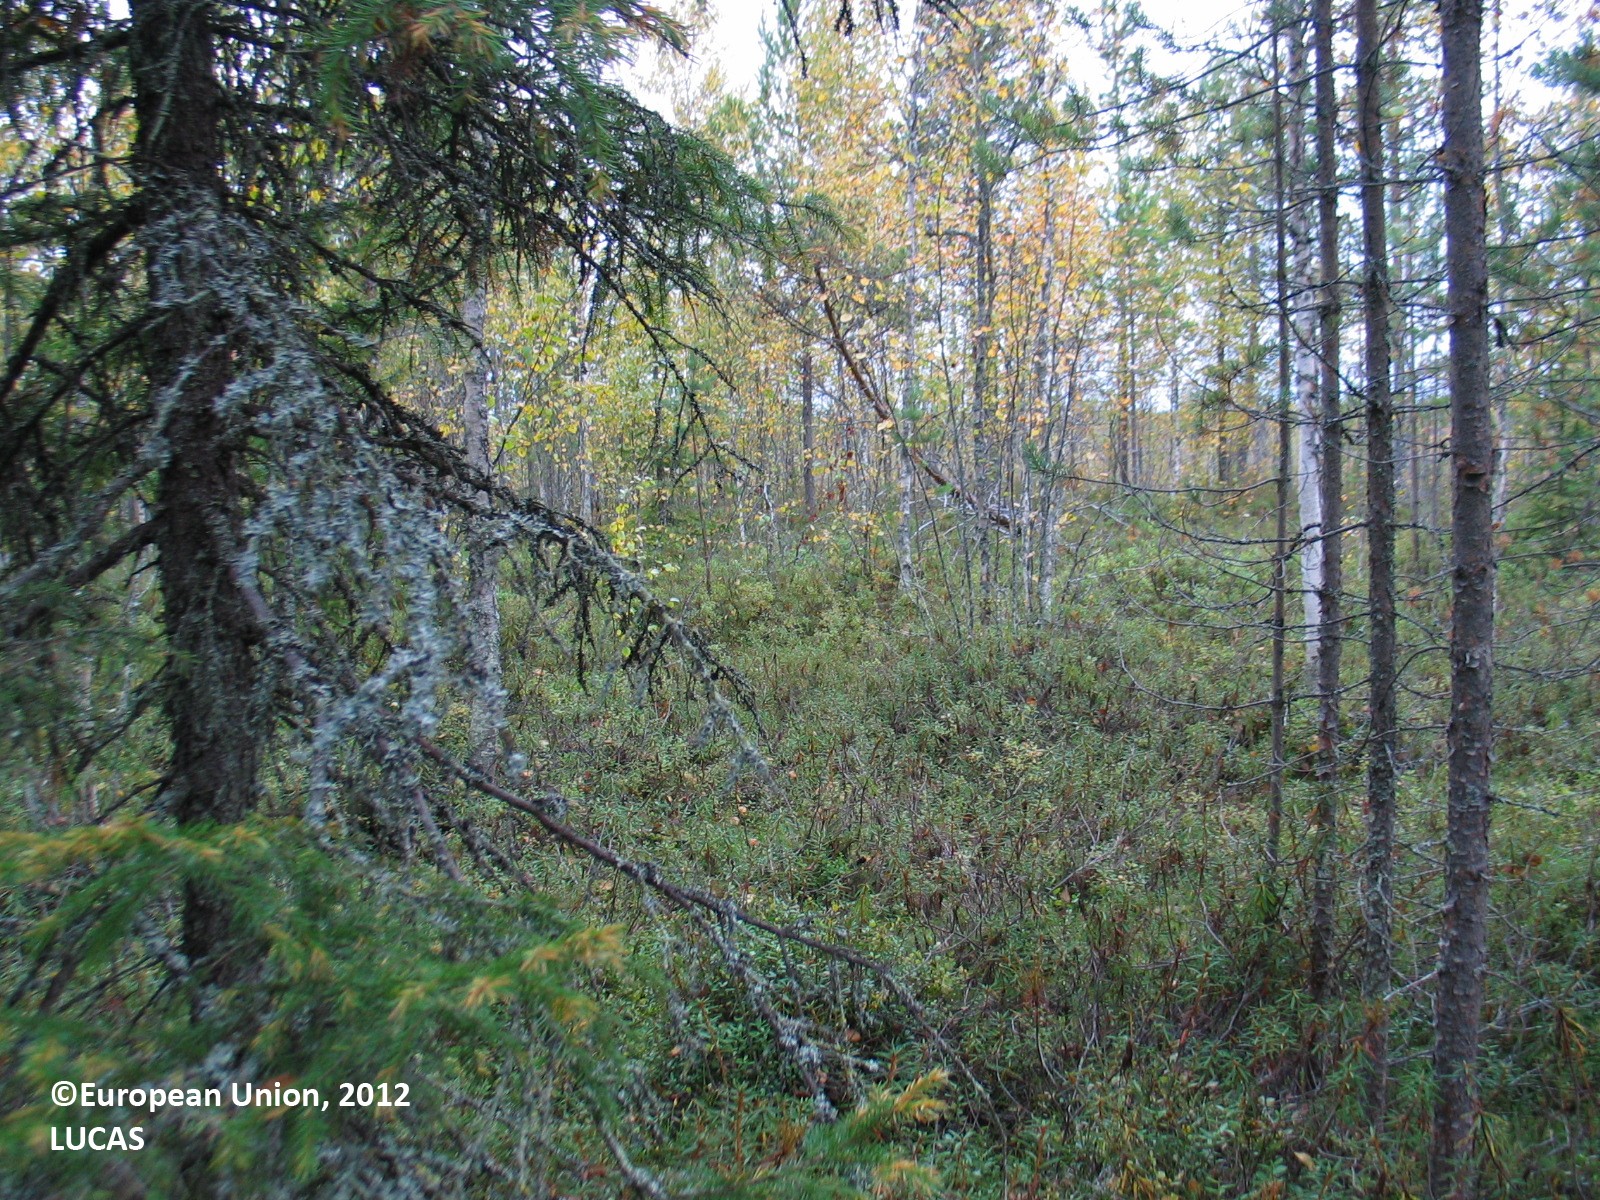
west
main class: Woodland
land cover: Other mixed woodland
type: boreal forest
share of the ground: 50 - 75 %
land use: Forestry
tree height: > 5 m
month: September
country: FI
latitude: 65.4795
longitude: 25.6948
